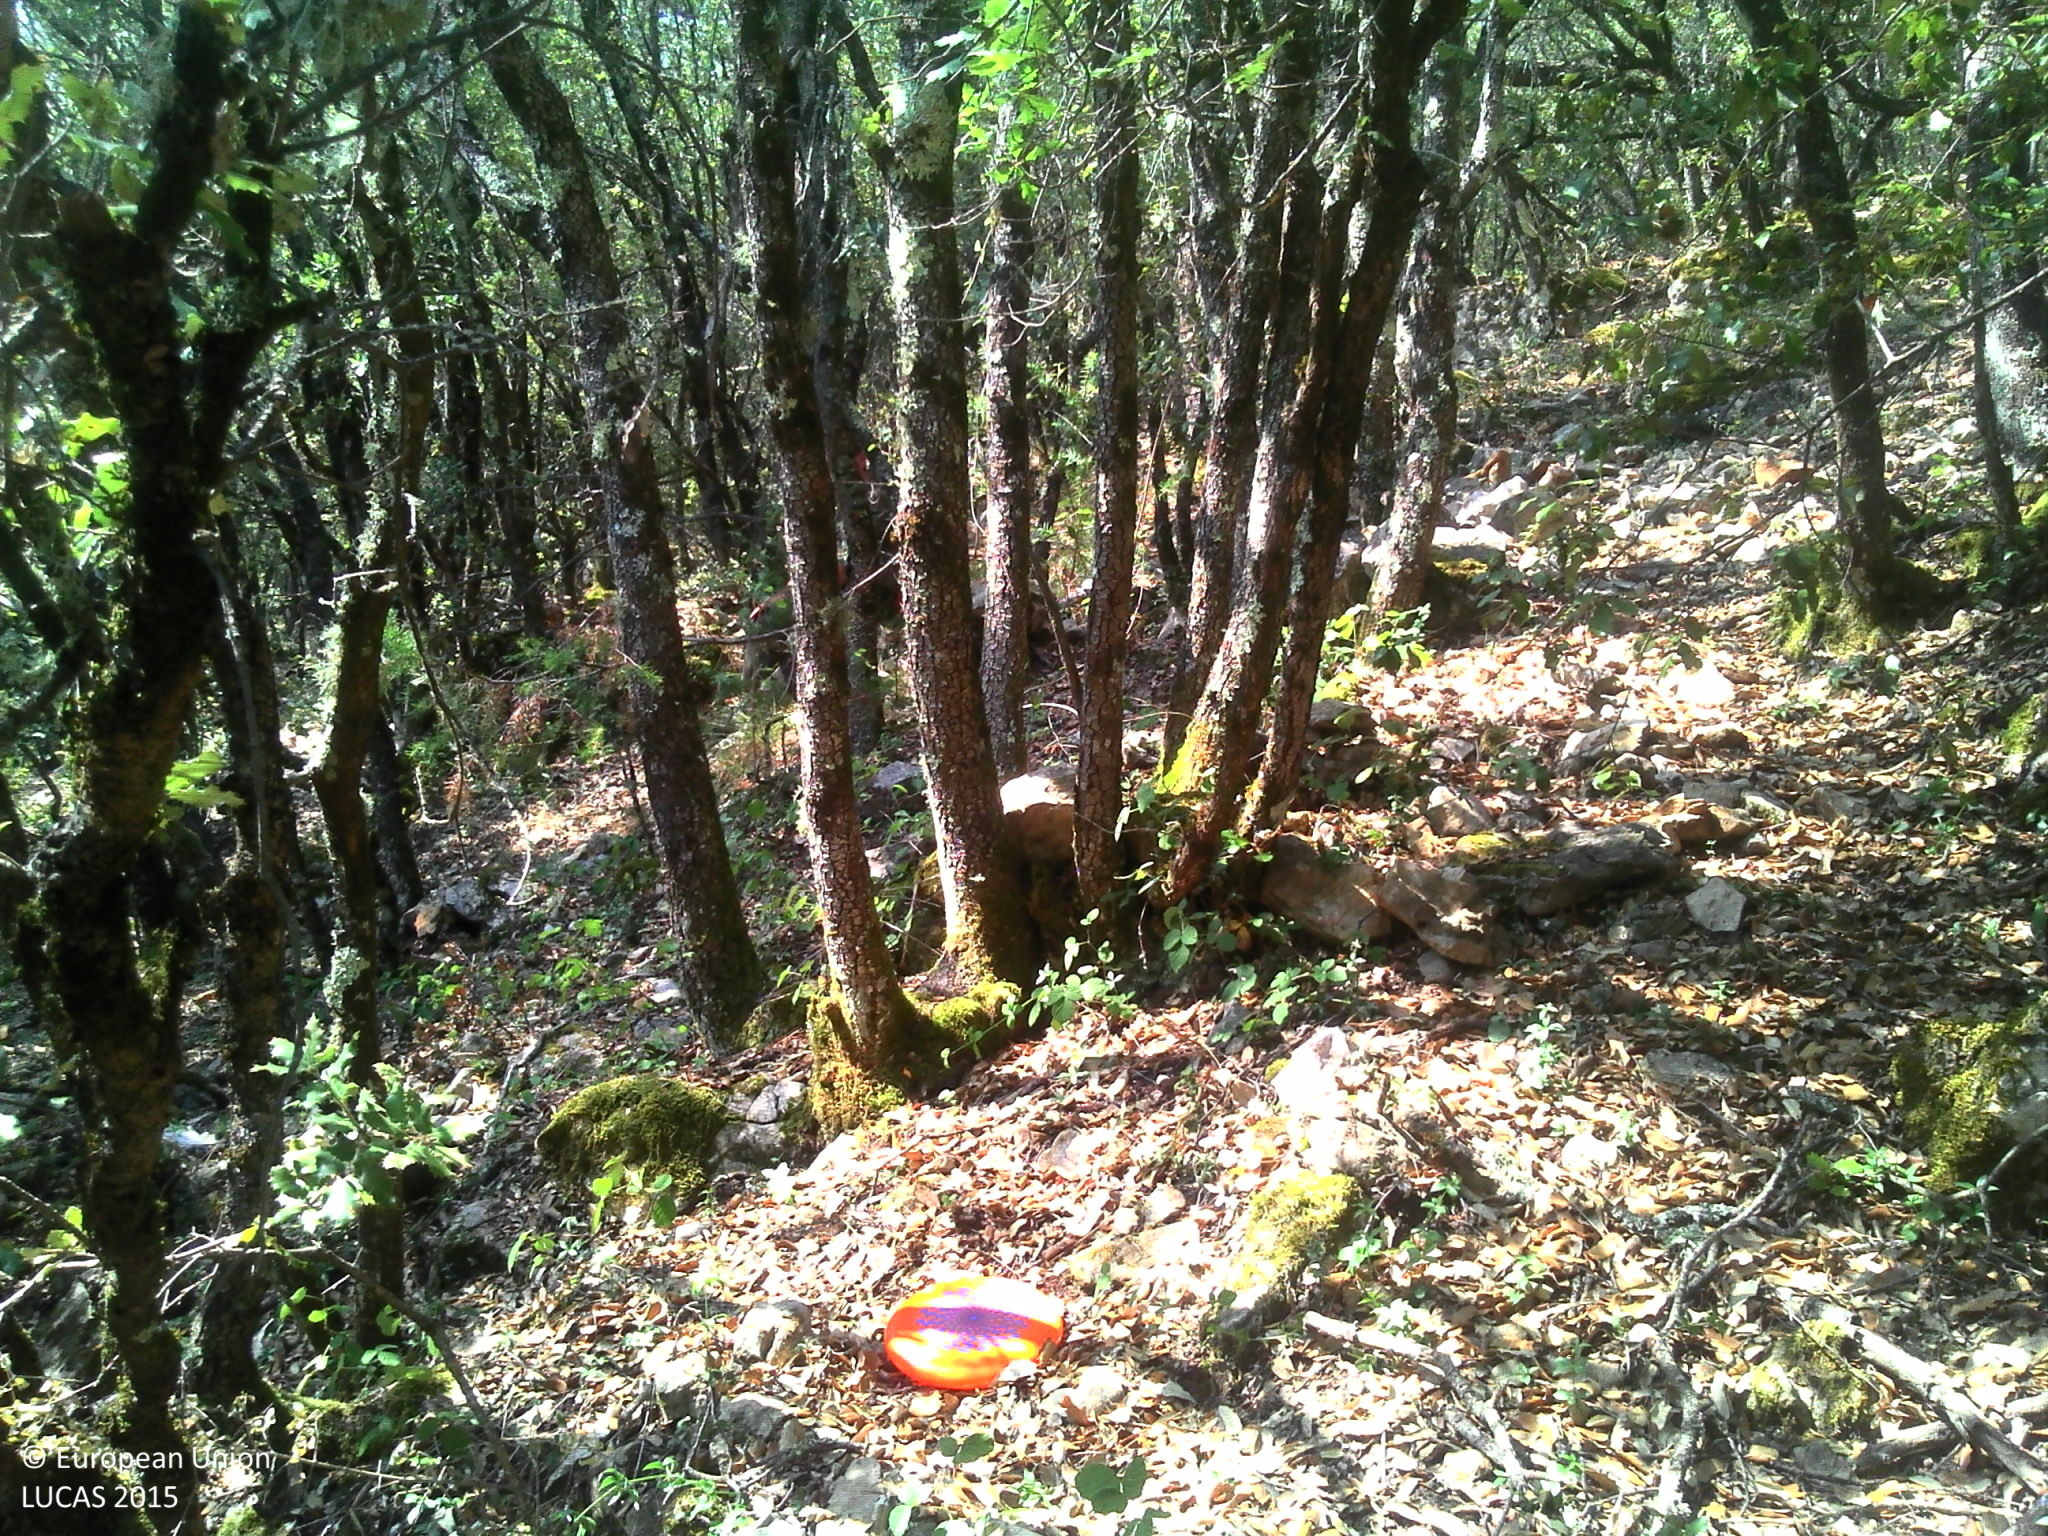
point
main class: Woodland
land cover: Broadleaved woodland
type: thermophilous deciduous forest
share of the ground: > 75 %
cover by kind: broadleaved forest trees 90 %, unconsolidated bare surface 10 %
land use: Semi-natural and natural areas not in use
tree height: > 5 m
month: August
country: FR
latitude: 43.6355
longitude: 6.3270
